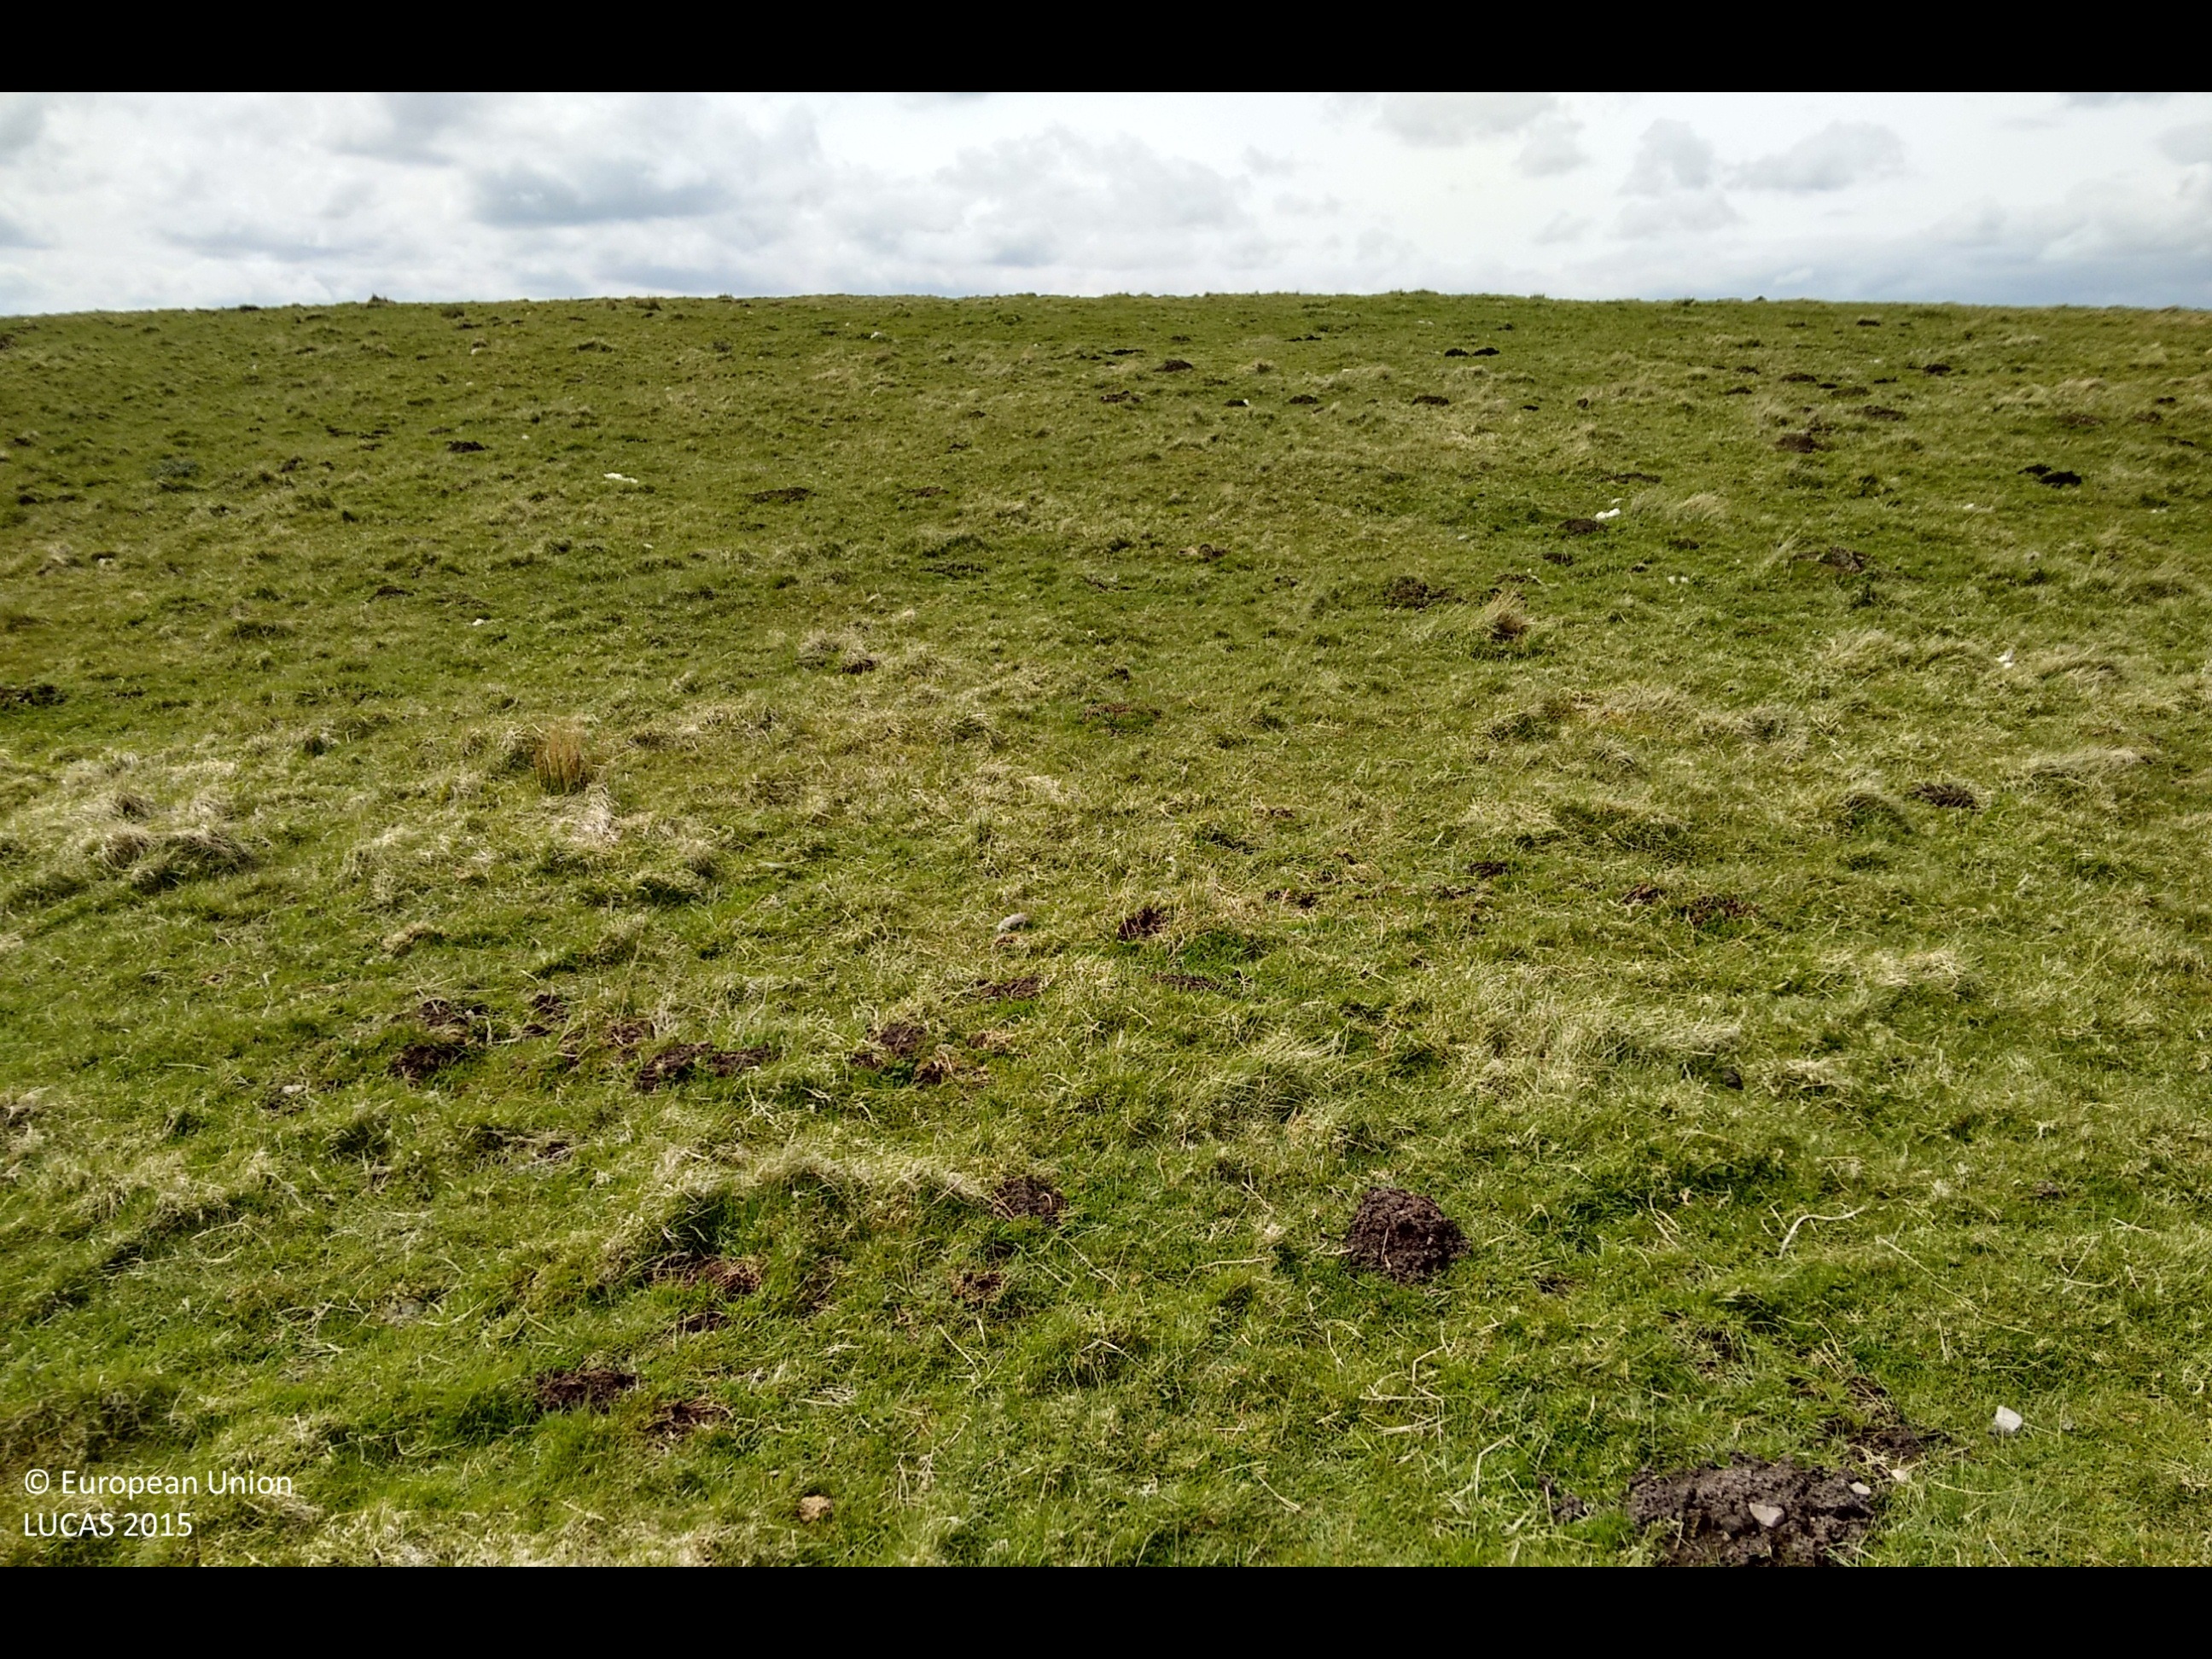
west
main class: Grassland
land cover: Grassland without tree/shrub cover
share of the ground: > 75 %
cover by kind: herbaceous plants 100 %
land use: Agriculture (excluding fallow land and kitchen gardens)
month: May
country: GB
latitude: 55.7862
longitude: -2.7417
